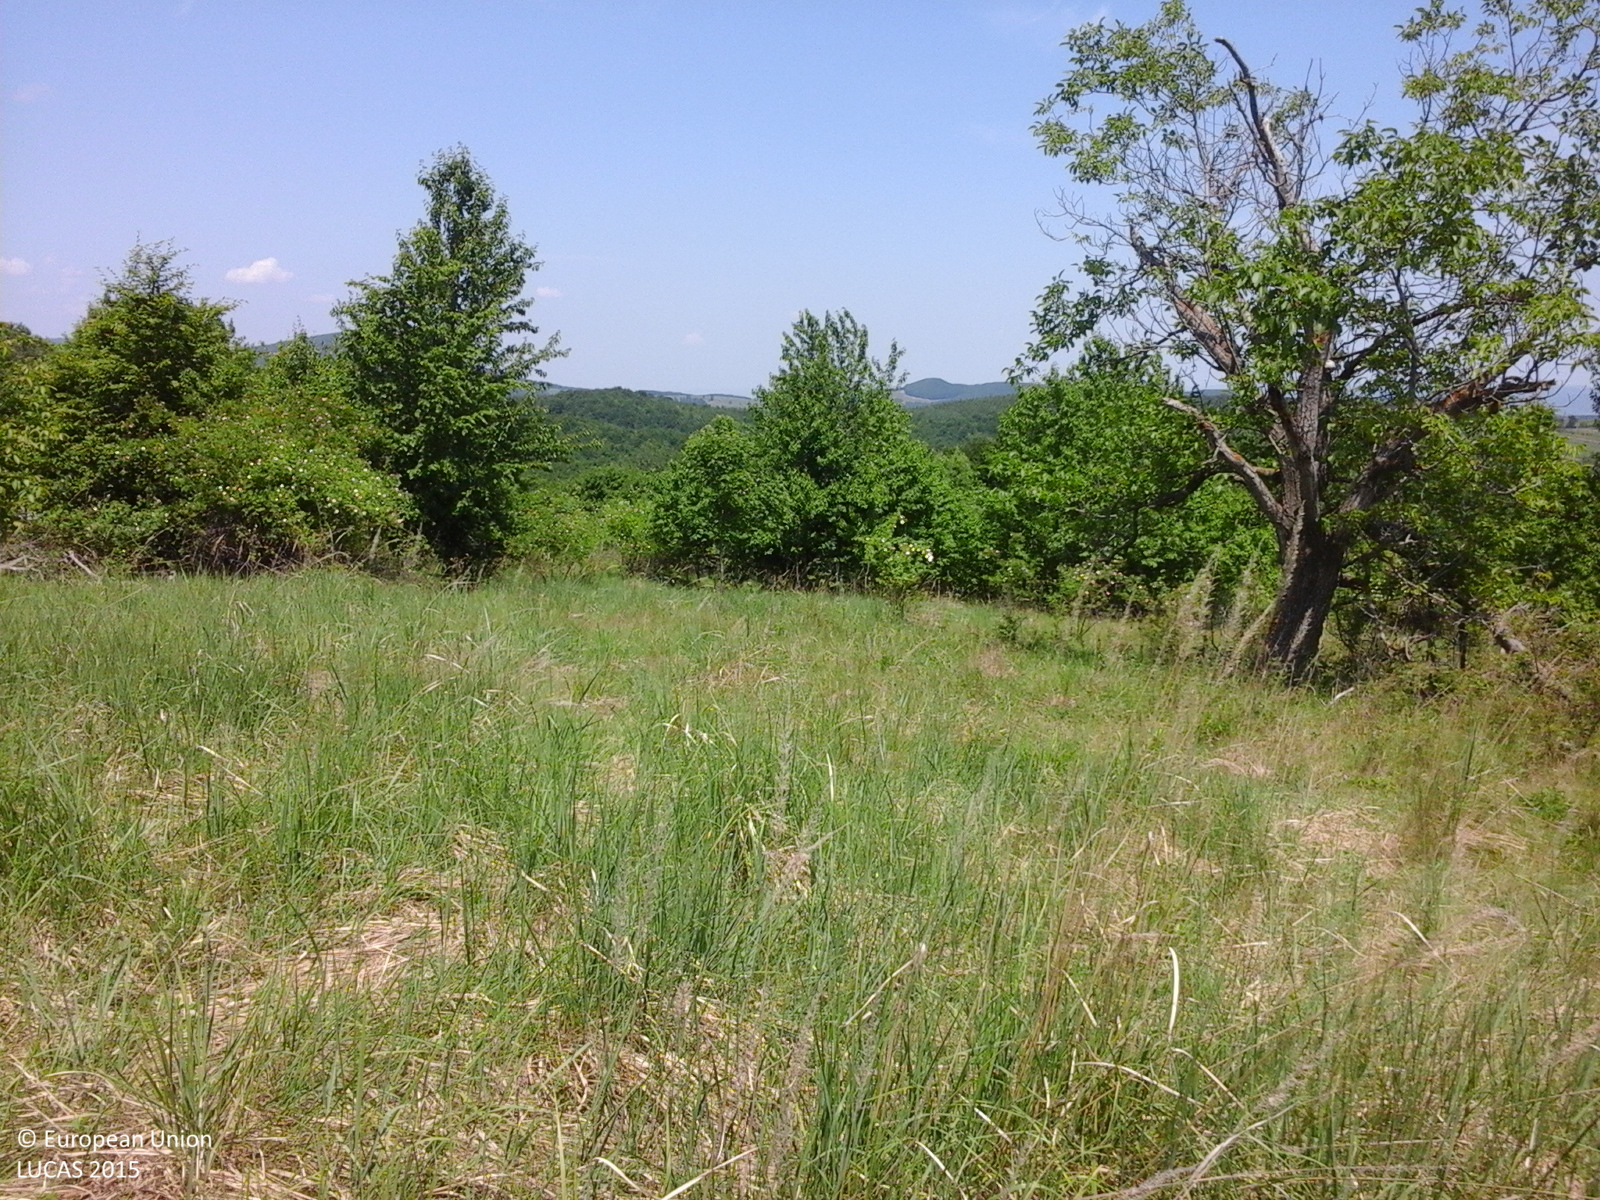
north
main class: Grassland
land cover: Grassland without tree/shrub cover
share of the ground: > 75 %
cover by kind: herbaceous plants 95 %, shrubs 5 %
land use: Agriculture (excluding fallow land and kitchen gardens)
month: June
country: RO
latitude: 46.3459
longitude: 26.8389
